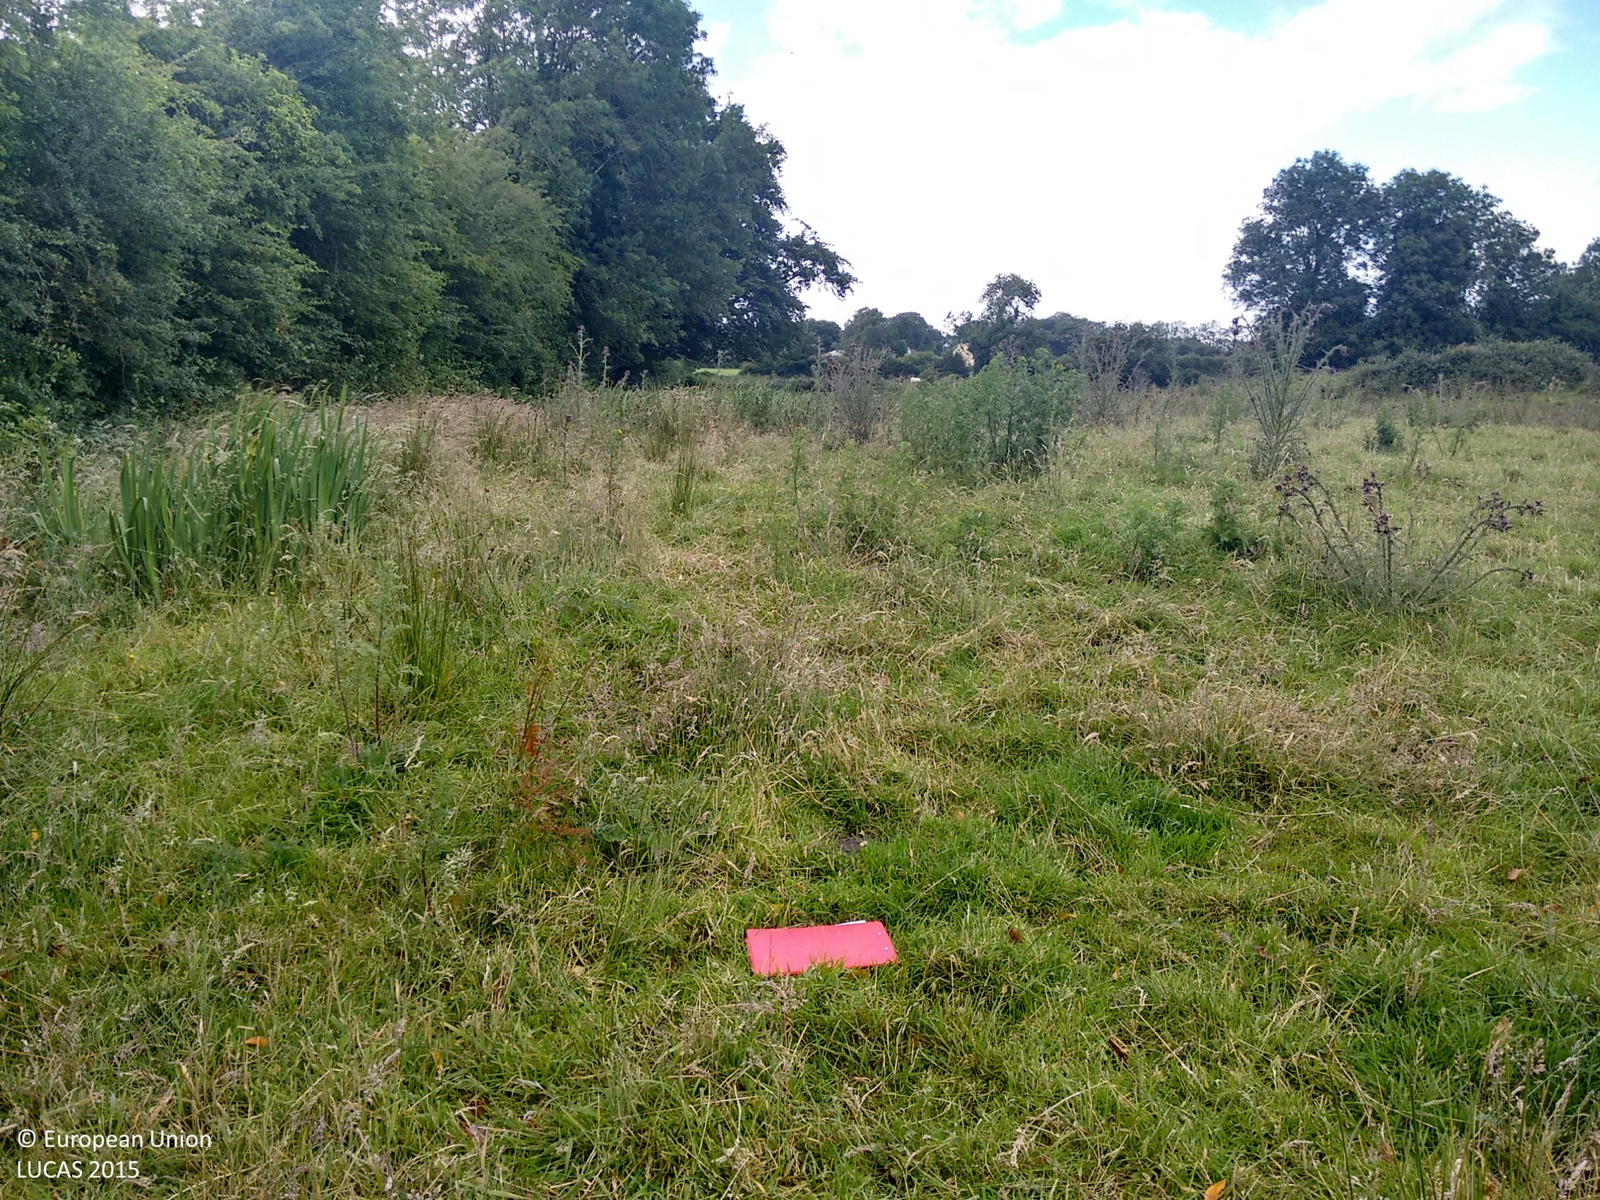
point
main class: Grassland
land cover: Grassland without tree/shrub cover
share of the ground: > 75 %
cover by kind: herbaceous plants 95 %, shrubs 5 %
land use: Agriculture (excluding fallow land and kitchen gardens)
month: July
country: IE
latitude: 53.6110
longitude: -7.7135
